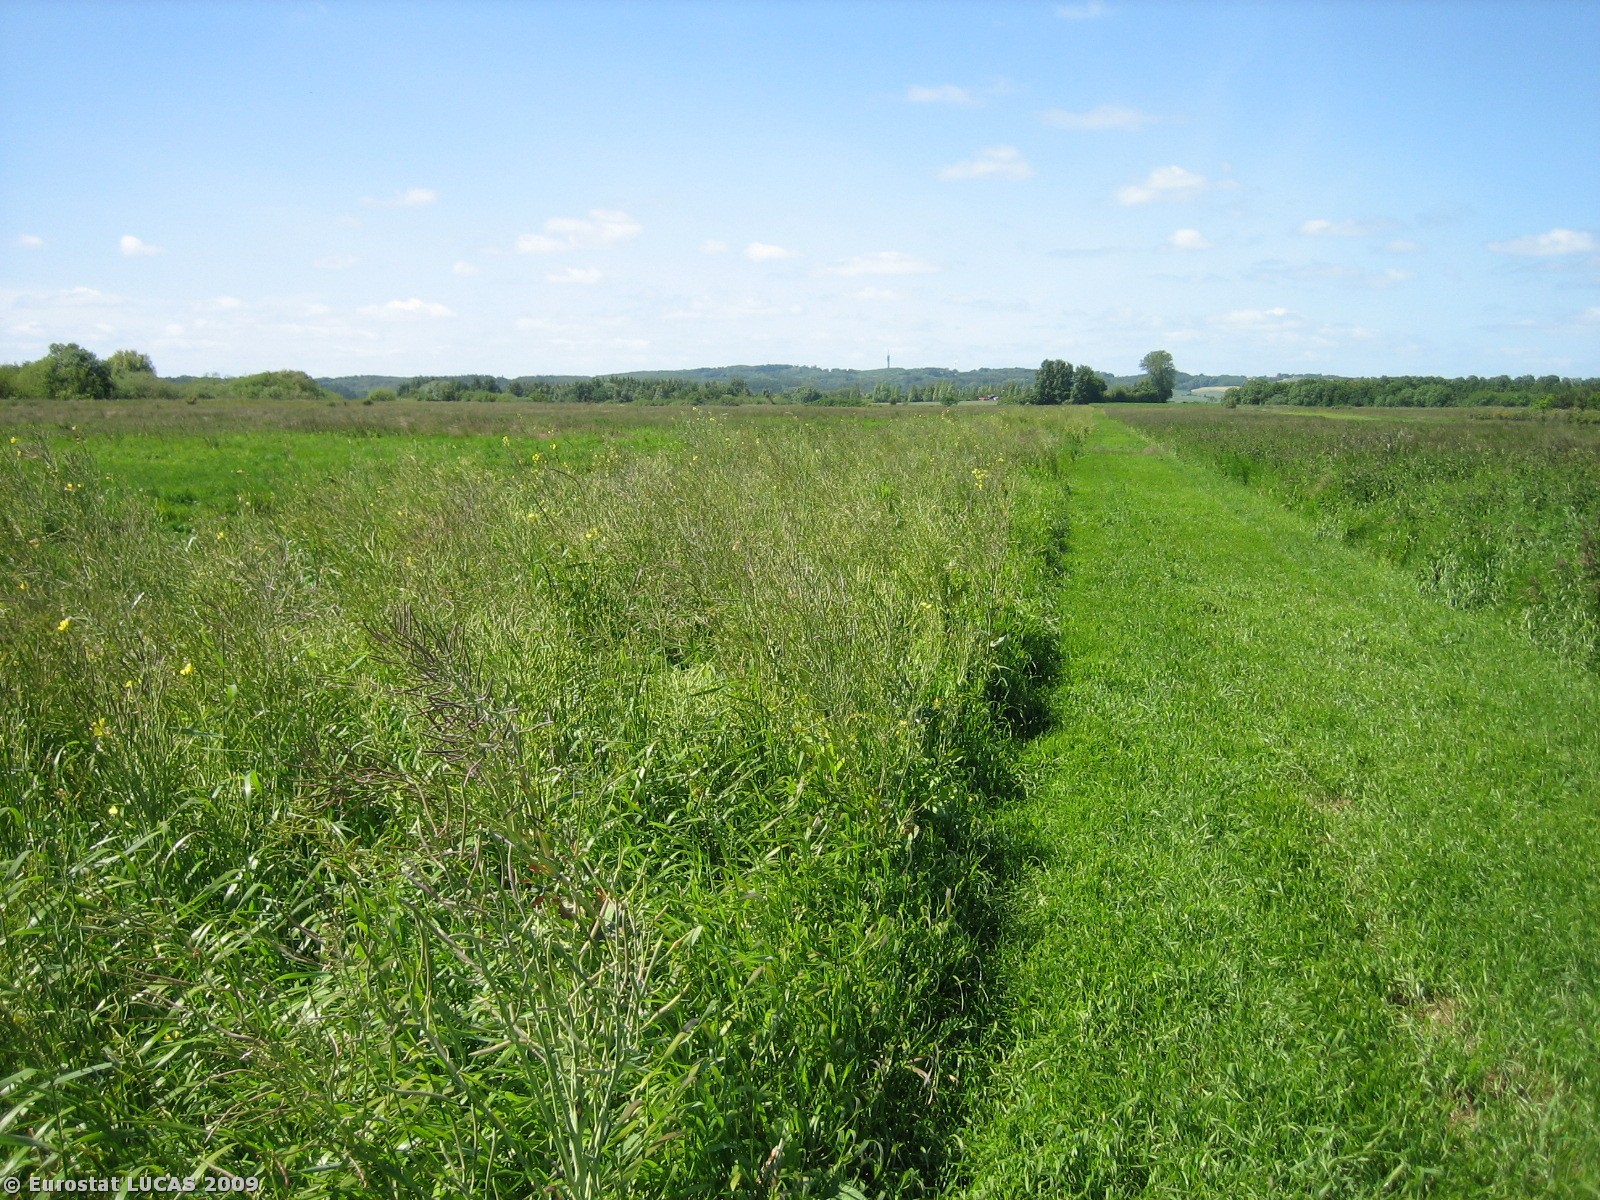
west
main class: Cropland
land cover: Rape and turnip rape
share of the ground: > 75 %
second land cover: Grassland without tree/shrub cover
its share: > 75 %
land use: Agriculture (excluding fallow land and kitchen gardens)
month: June
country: DK
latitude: 55.7384
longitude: 10.0159
